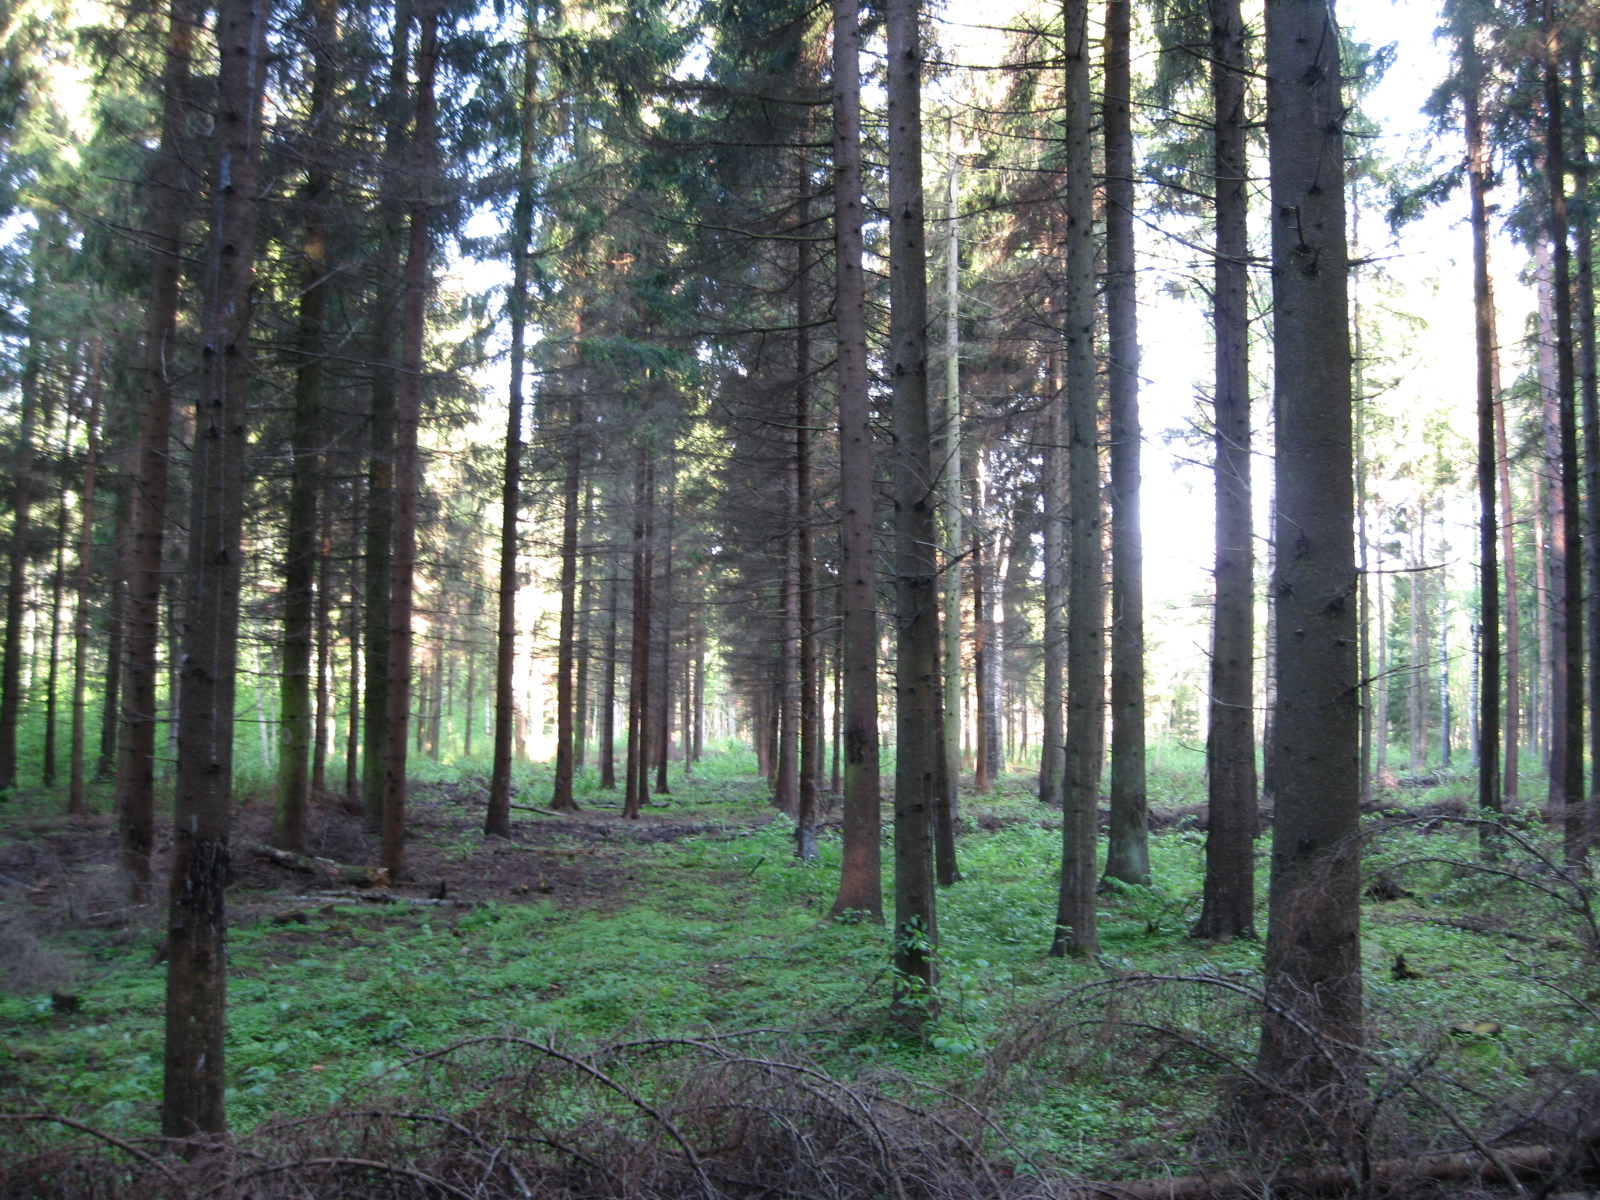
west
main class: Woodland
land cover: Spruce dominated coniferous woodland
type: hemiboreal forest and nemoral coniferous forest and mixed broadleaved-coniferous forest
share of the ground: > 75 %
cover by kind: coniferous forest trees 80 %, herbaceous plants 10 %, broadleaved forest trees 5 %, shrubs 5 %
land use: Forestry
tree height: > 5 m
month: May
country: LT
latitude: 56.3280
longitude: 24.0103
